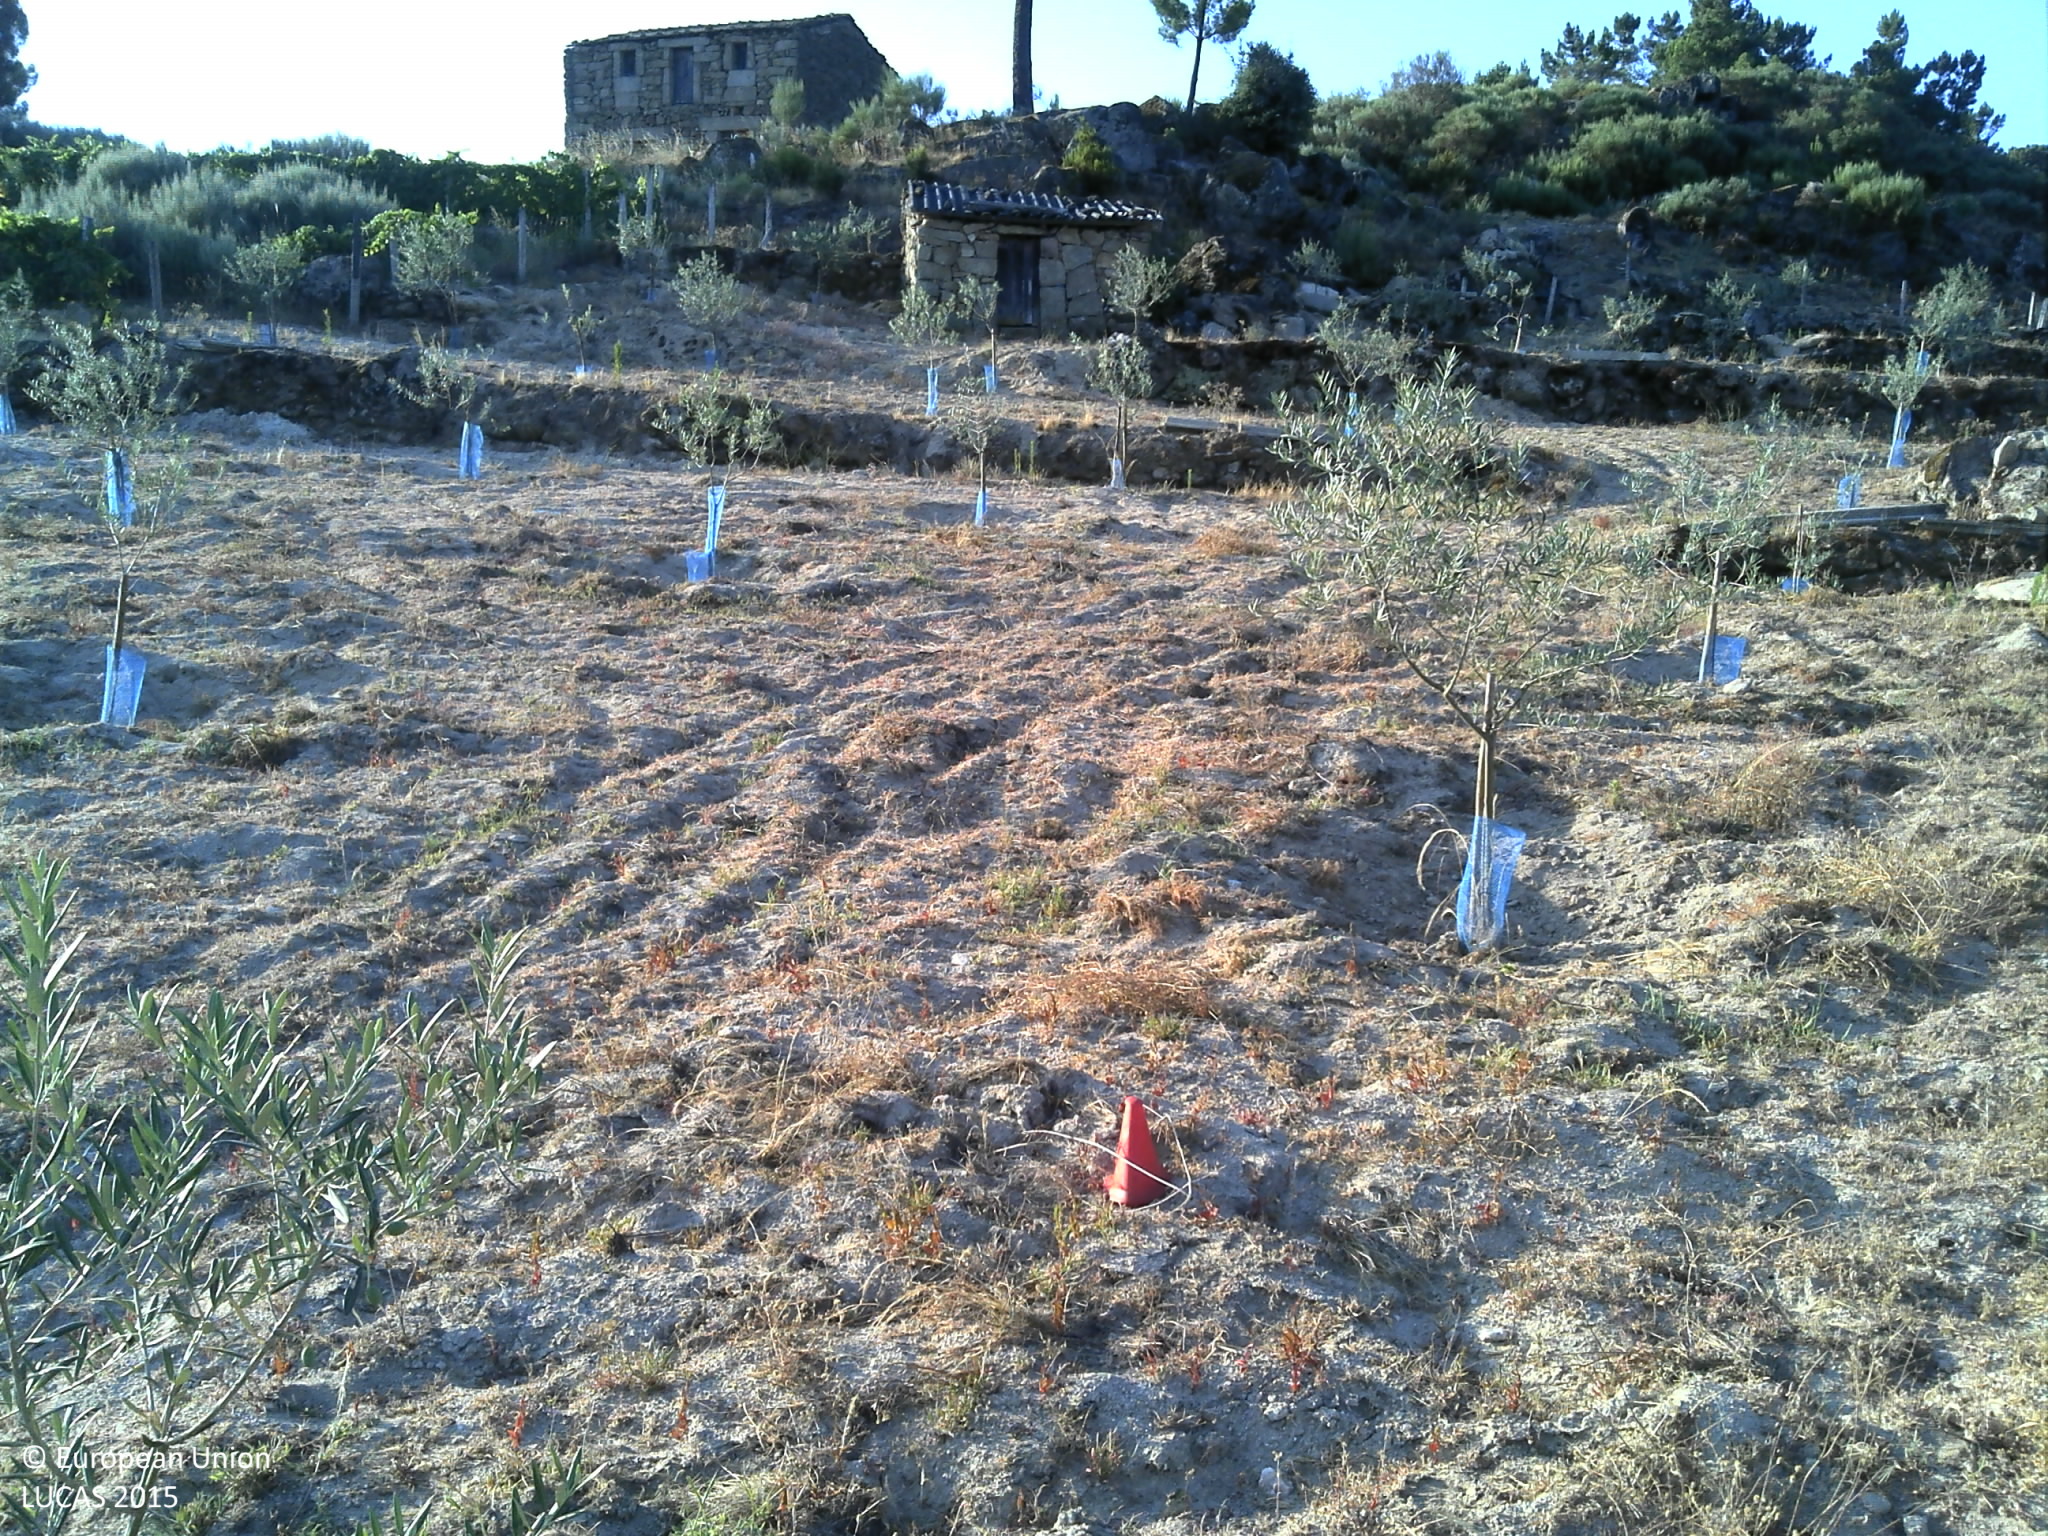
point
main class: Cropland
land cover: Olive groves
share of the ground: < 10 %
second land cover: Other bare soil
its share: > 75 %
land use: Agriculture (excluding fallow land and kitchen gardens)
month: July
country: PT
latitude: 41.3832
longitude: -7.4513
